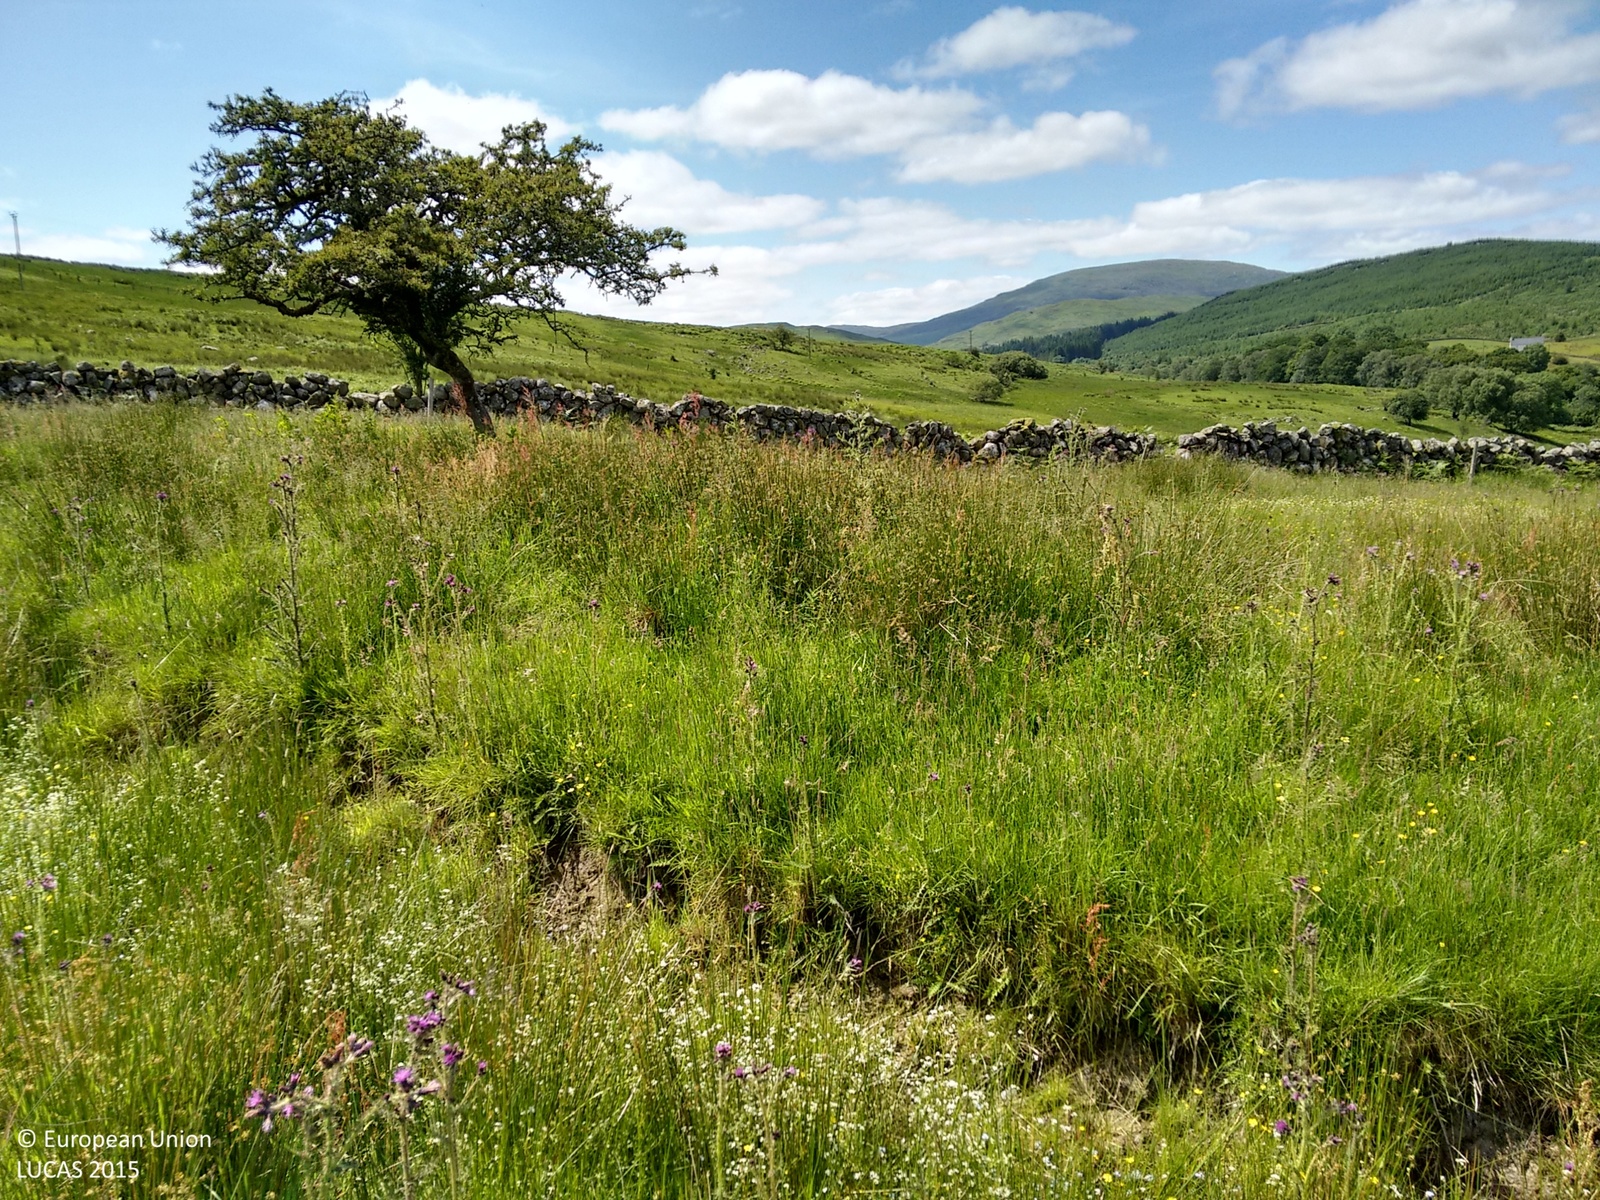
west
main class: Grassland
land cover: Grassland without tree/shrub cover
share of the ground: > 75 %
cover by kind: herbaceous plants 100 %
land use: Agriculture (excluding fallow land and kitchen gardens)
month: July
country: GB
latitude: 55.1157
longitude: -4.2212
